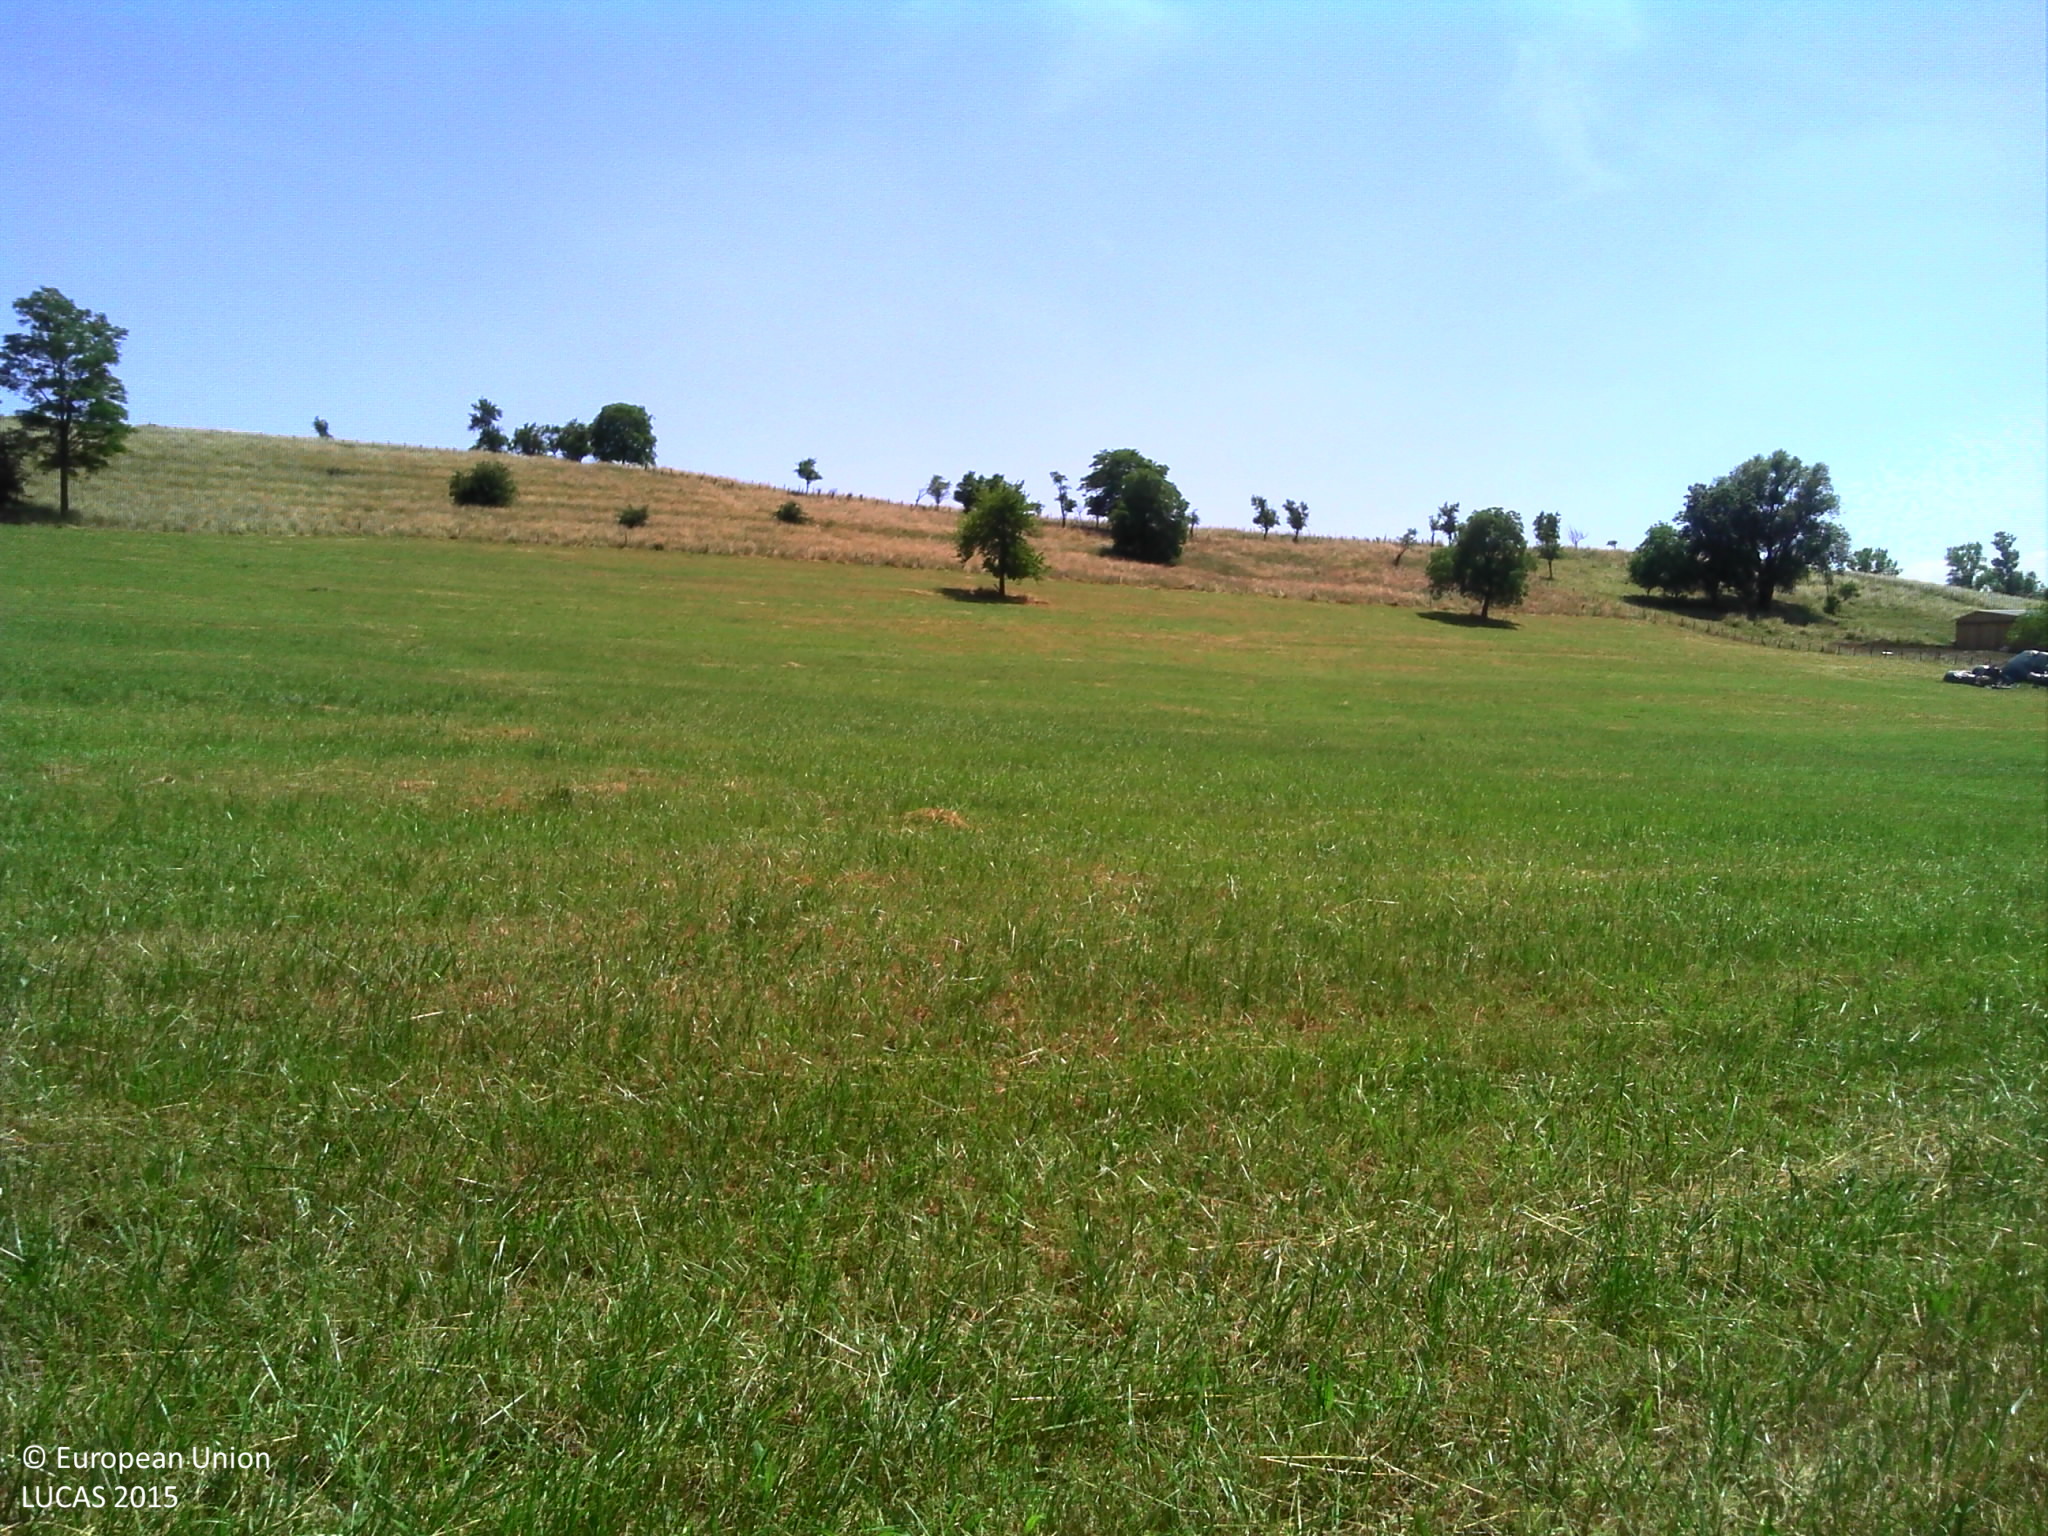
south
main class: Grassland
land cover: Grassland without tree/shrub cover
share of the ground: > 75 %
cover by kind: herbaceous plants 100 %
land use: Agriculture (excluding fallow land and kitchen gardens)
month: June
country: FR
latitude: 48.7193
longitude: 7.5949
